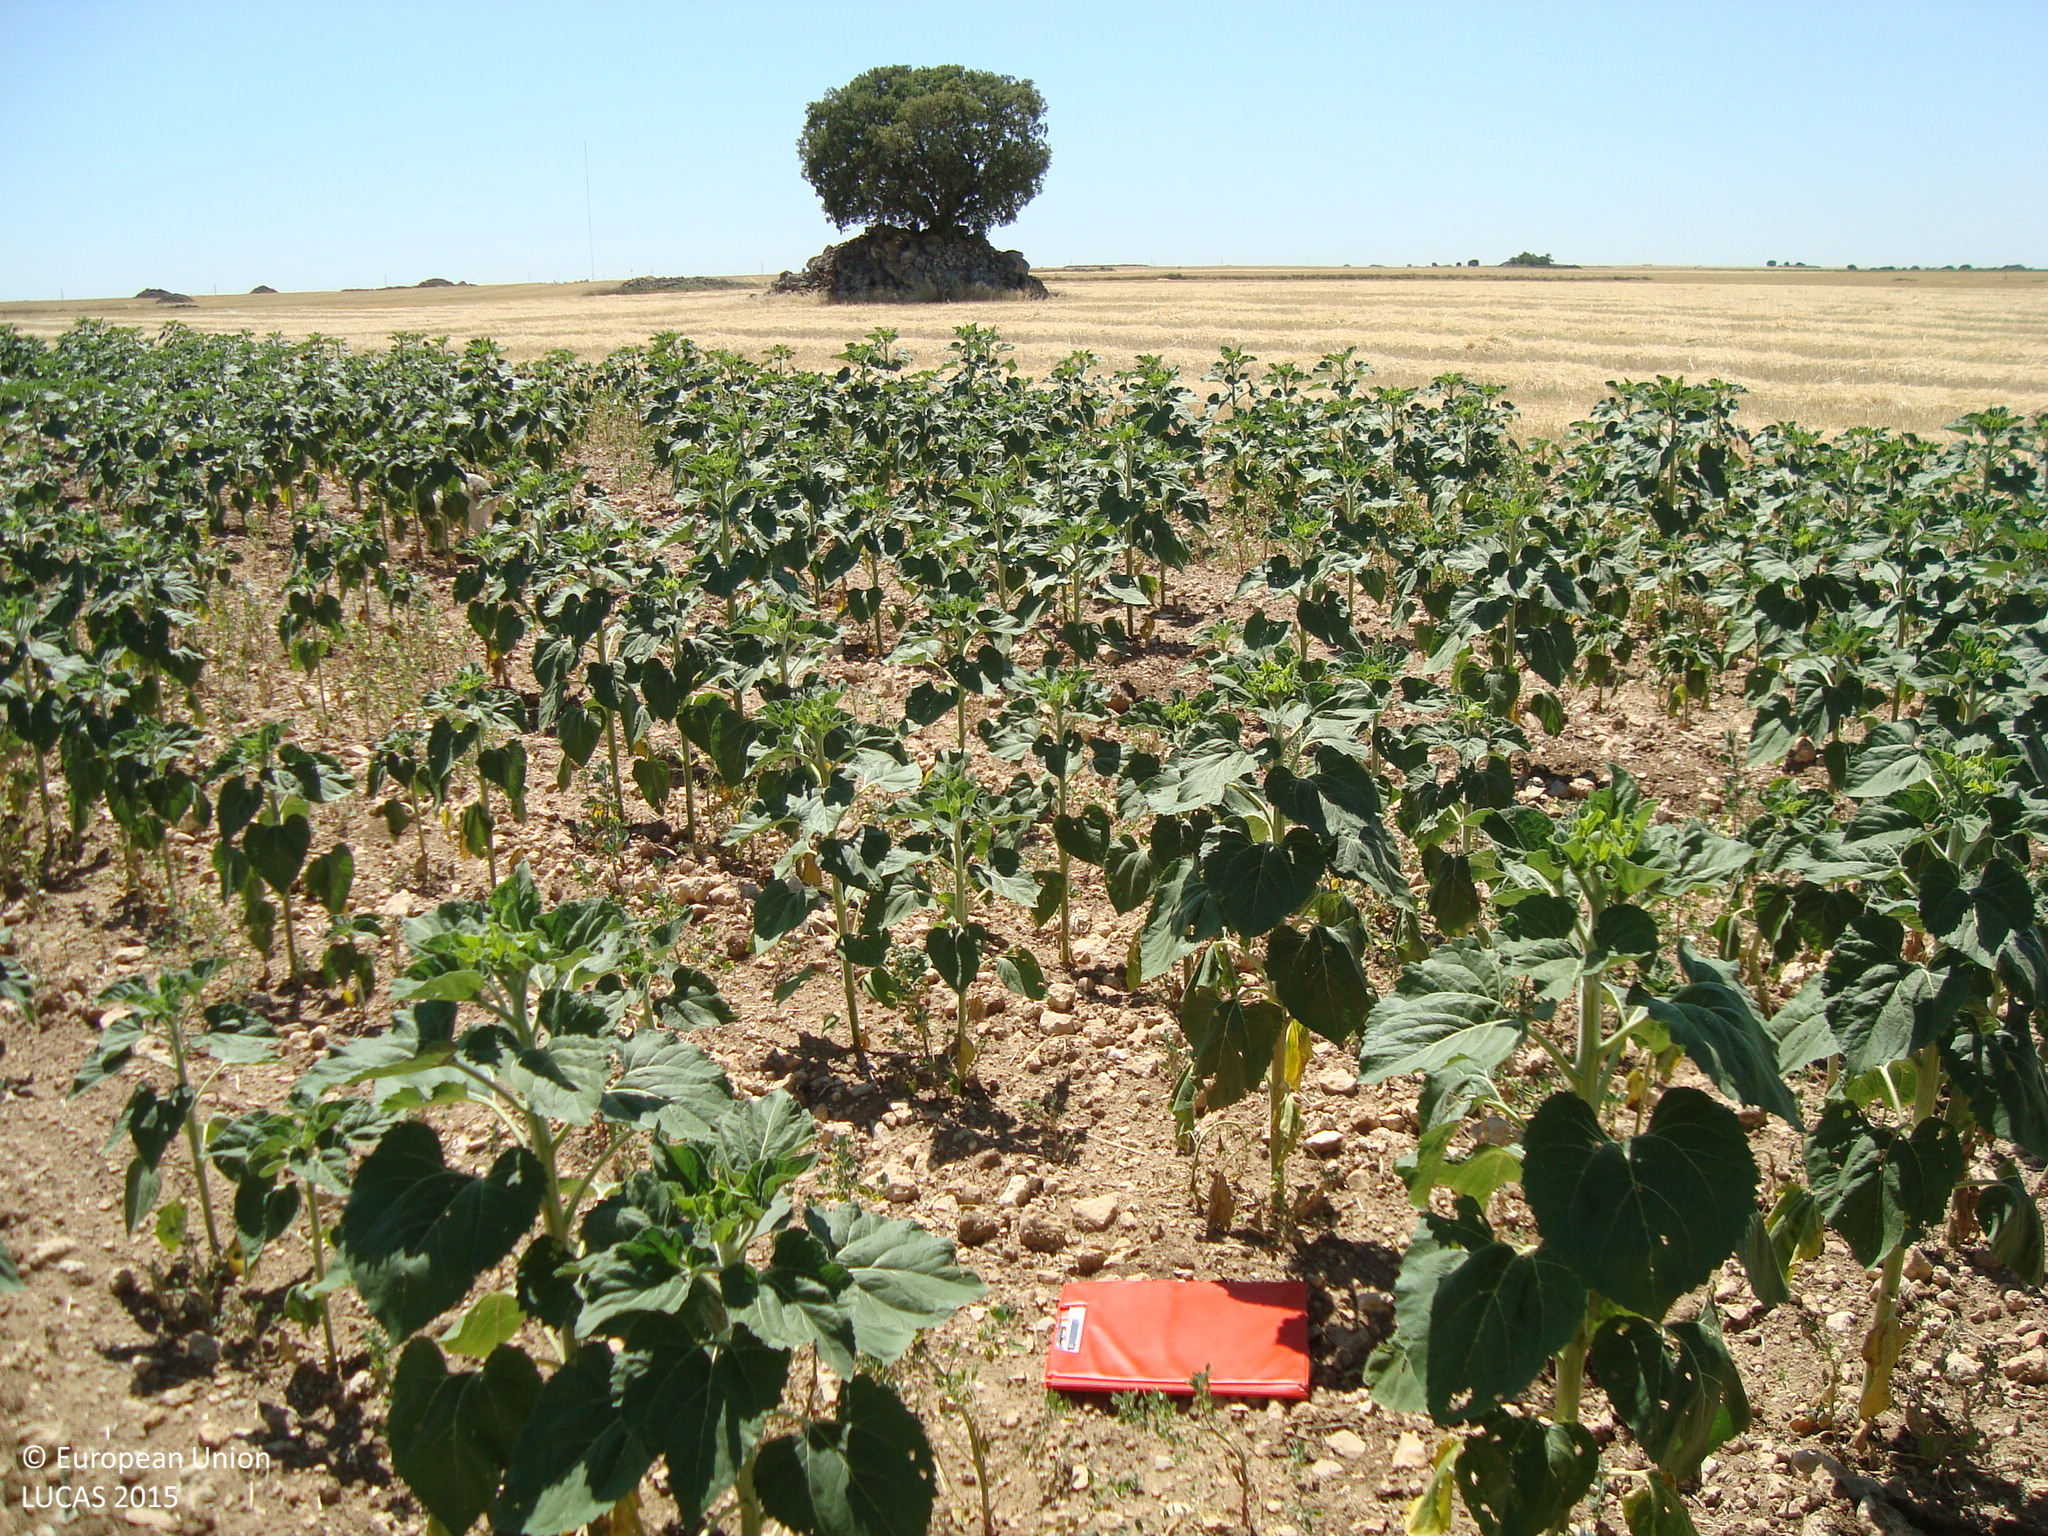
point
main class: Cropland
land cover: Sunflower
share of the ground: > 75 %
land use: Agriculture (excluding fallow land and kitchen gardens)
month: July
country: ES
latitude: 41.7079
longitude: -4.0353
